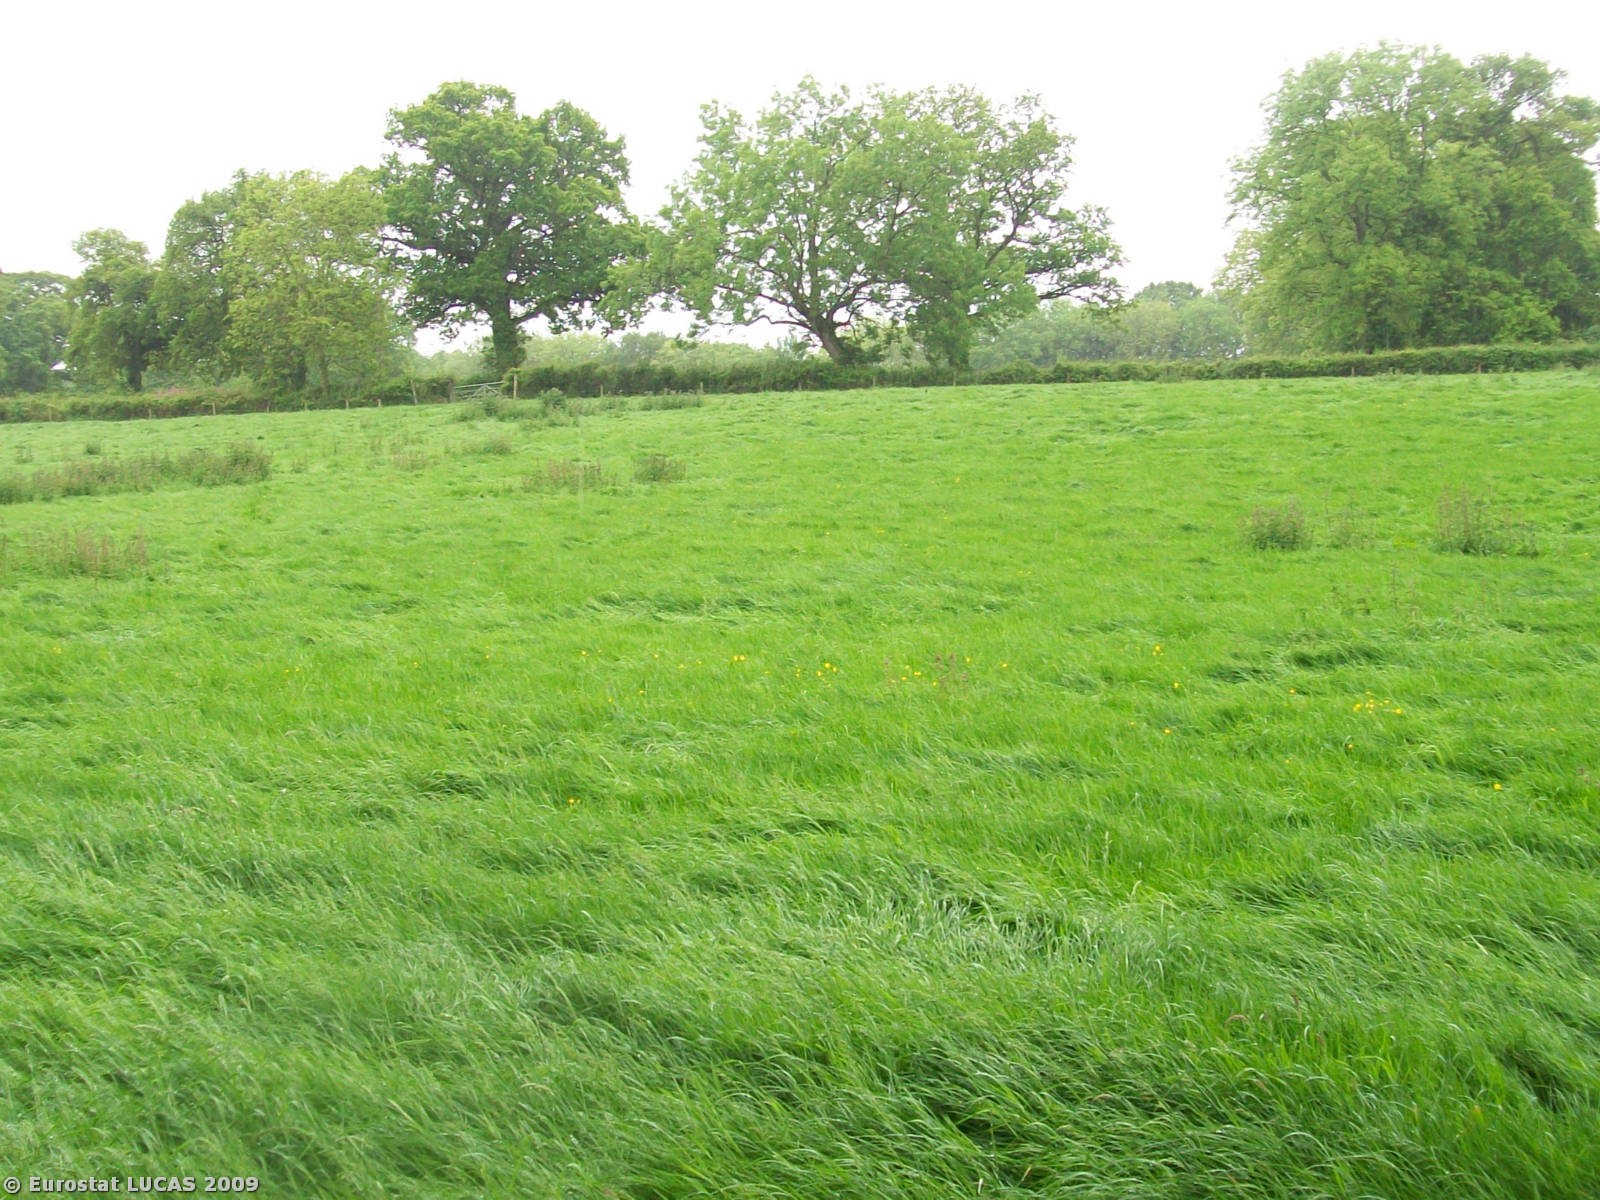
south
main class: Grassland
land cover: Grassland without tree/shrub cover
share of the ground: > 75 %
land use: Agriculture (excluding fallow land and kitchen gardens)
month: May
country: GB
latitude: 50.7636
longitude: -3.3369
